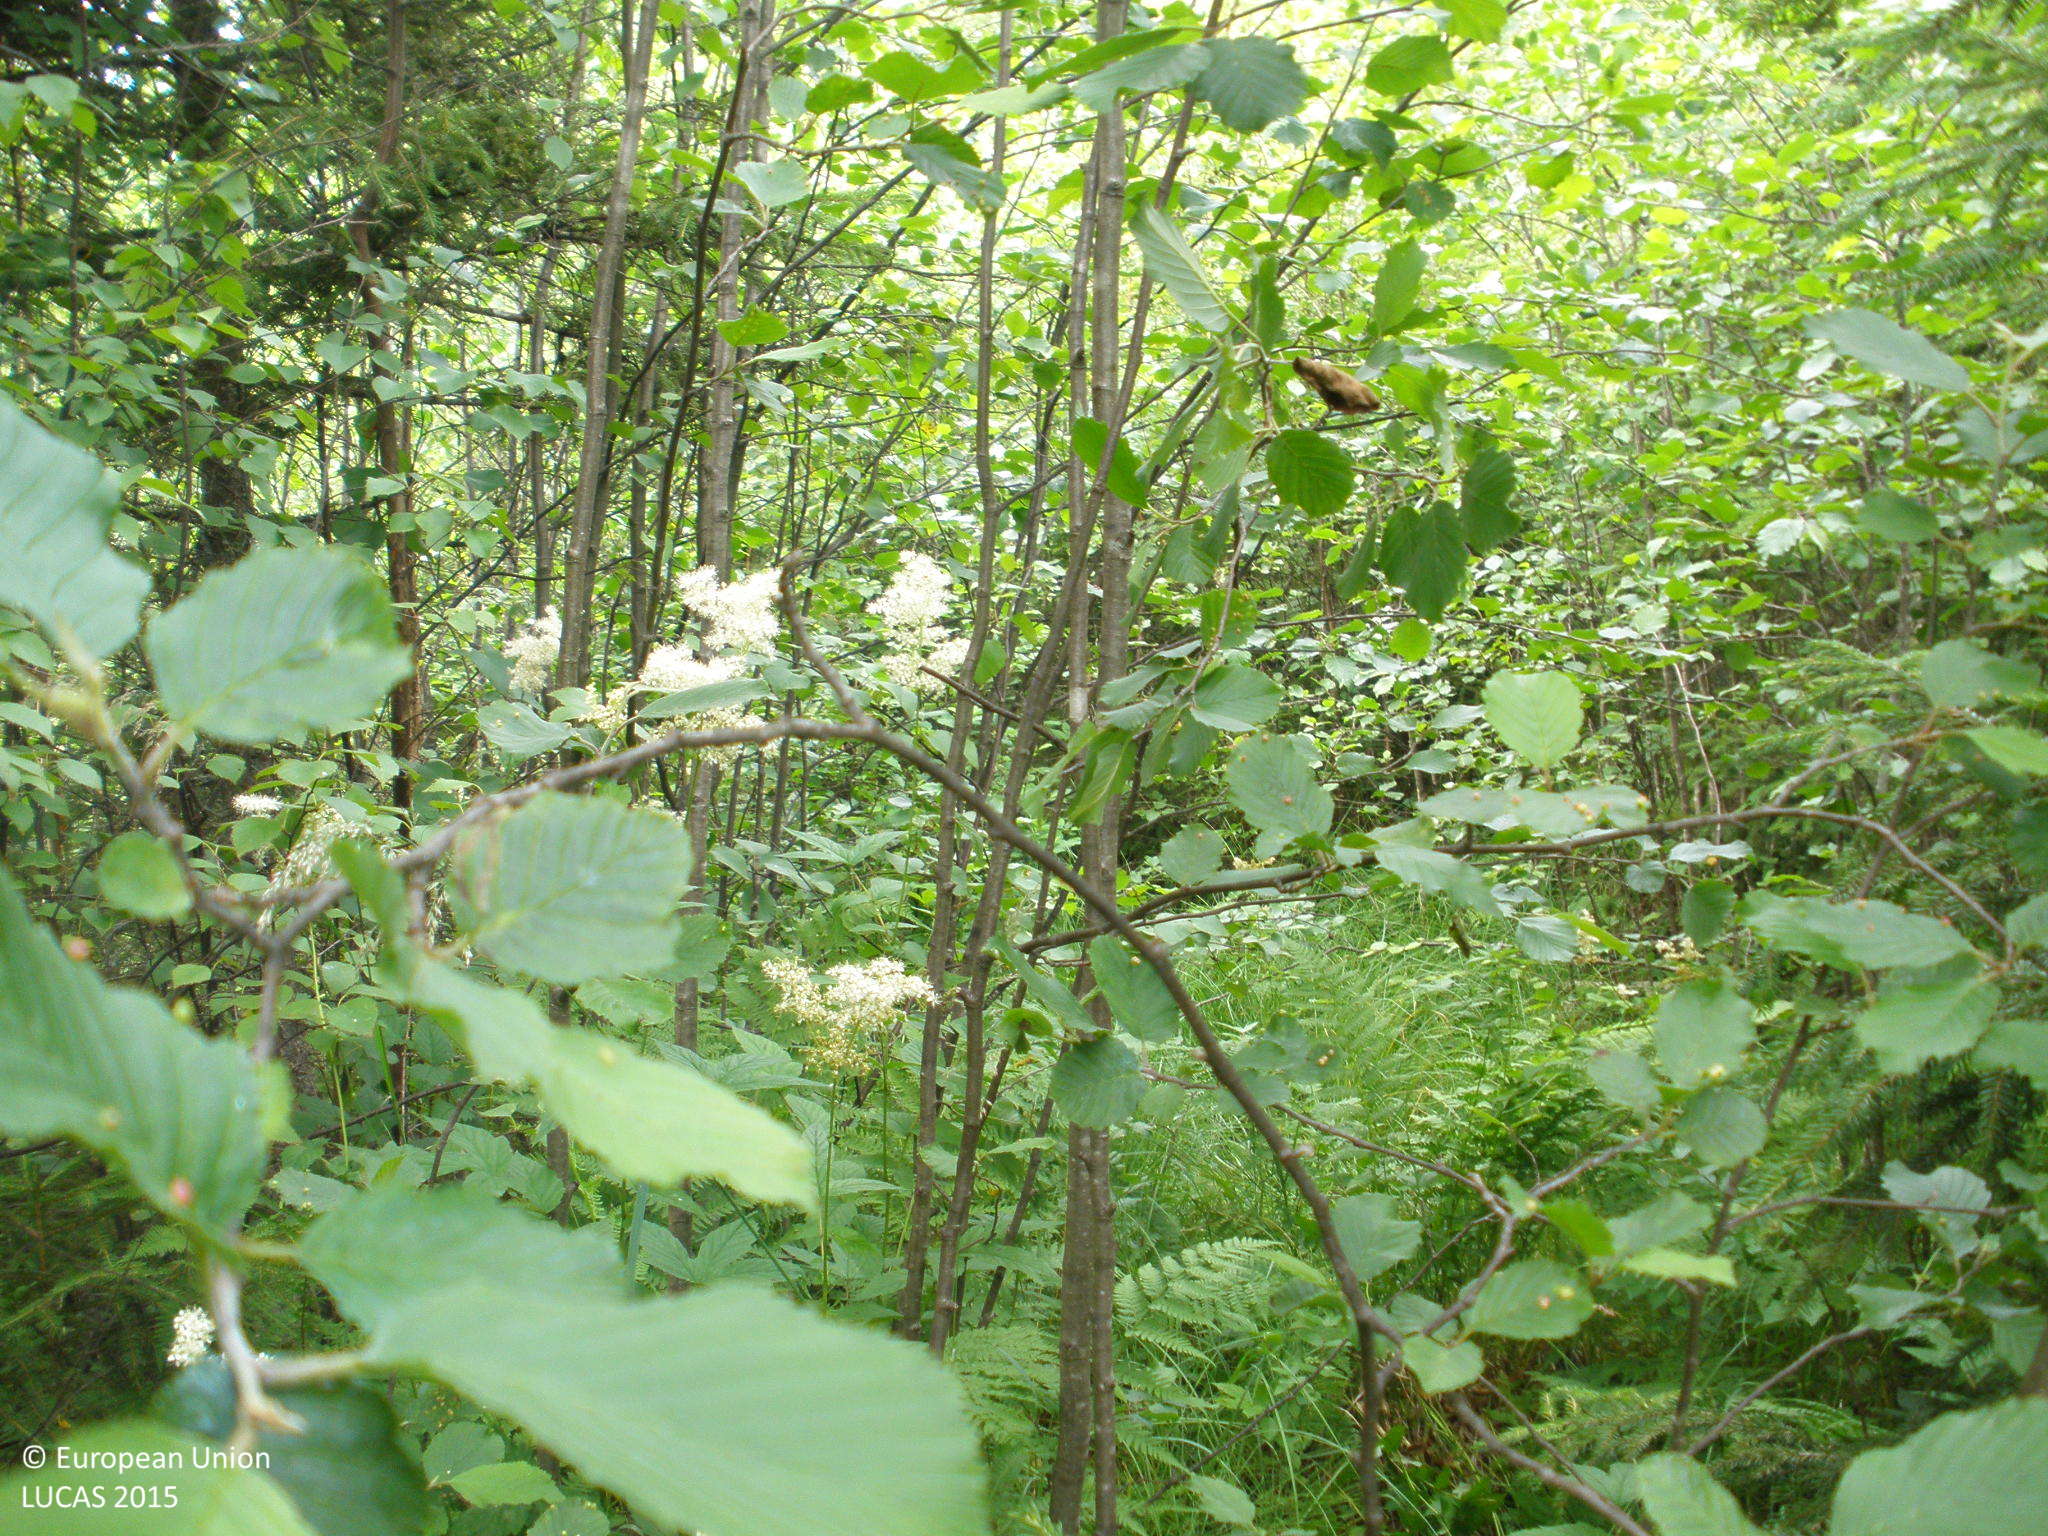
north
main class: Woodland
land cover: Broadleaved woodland
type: boreal forest
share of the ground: > 75 %
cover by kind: broadleaved forest trees 75 %, coniferous forest trees 10 %, herbaceous plants 10 %, shrubs 5 %
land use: Forestry
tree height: < 5 m
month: July
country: FI
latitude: 60.9800
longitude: 24.1961
